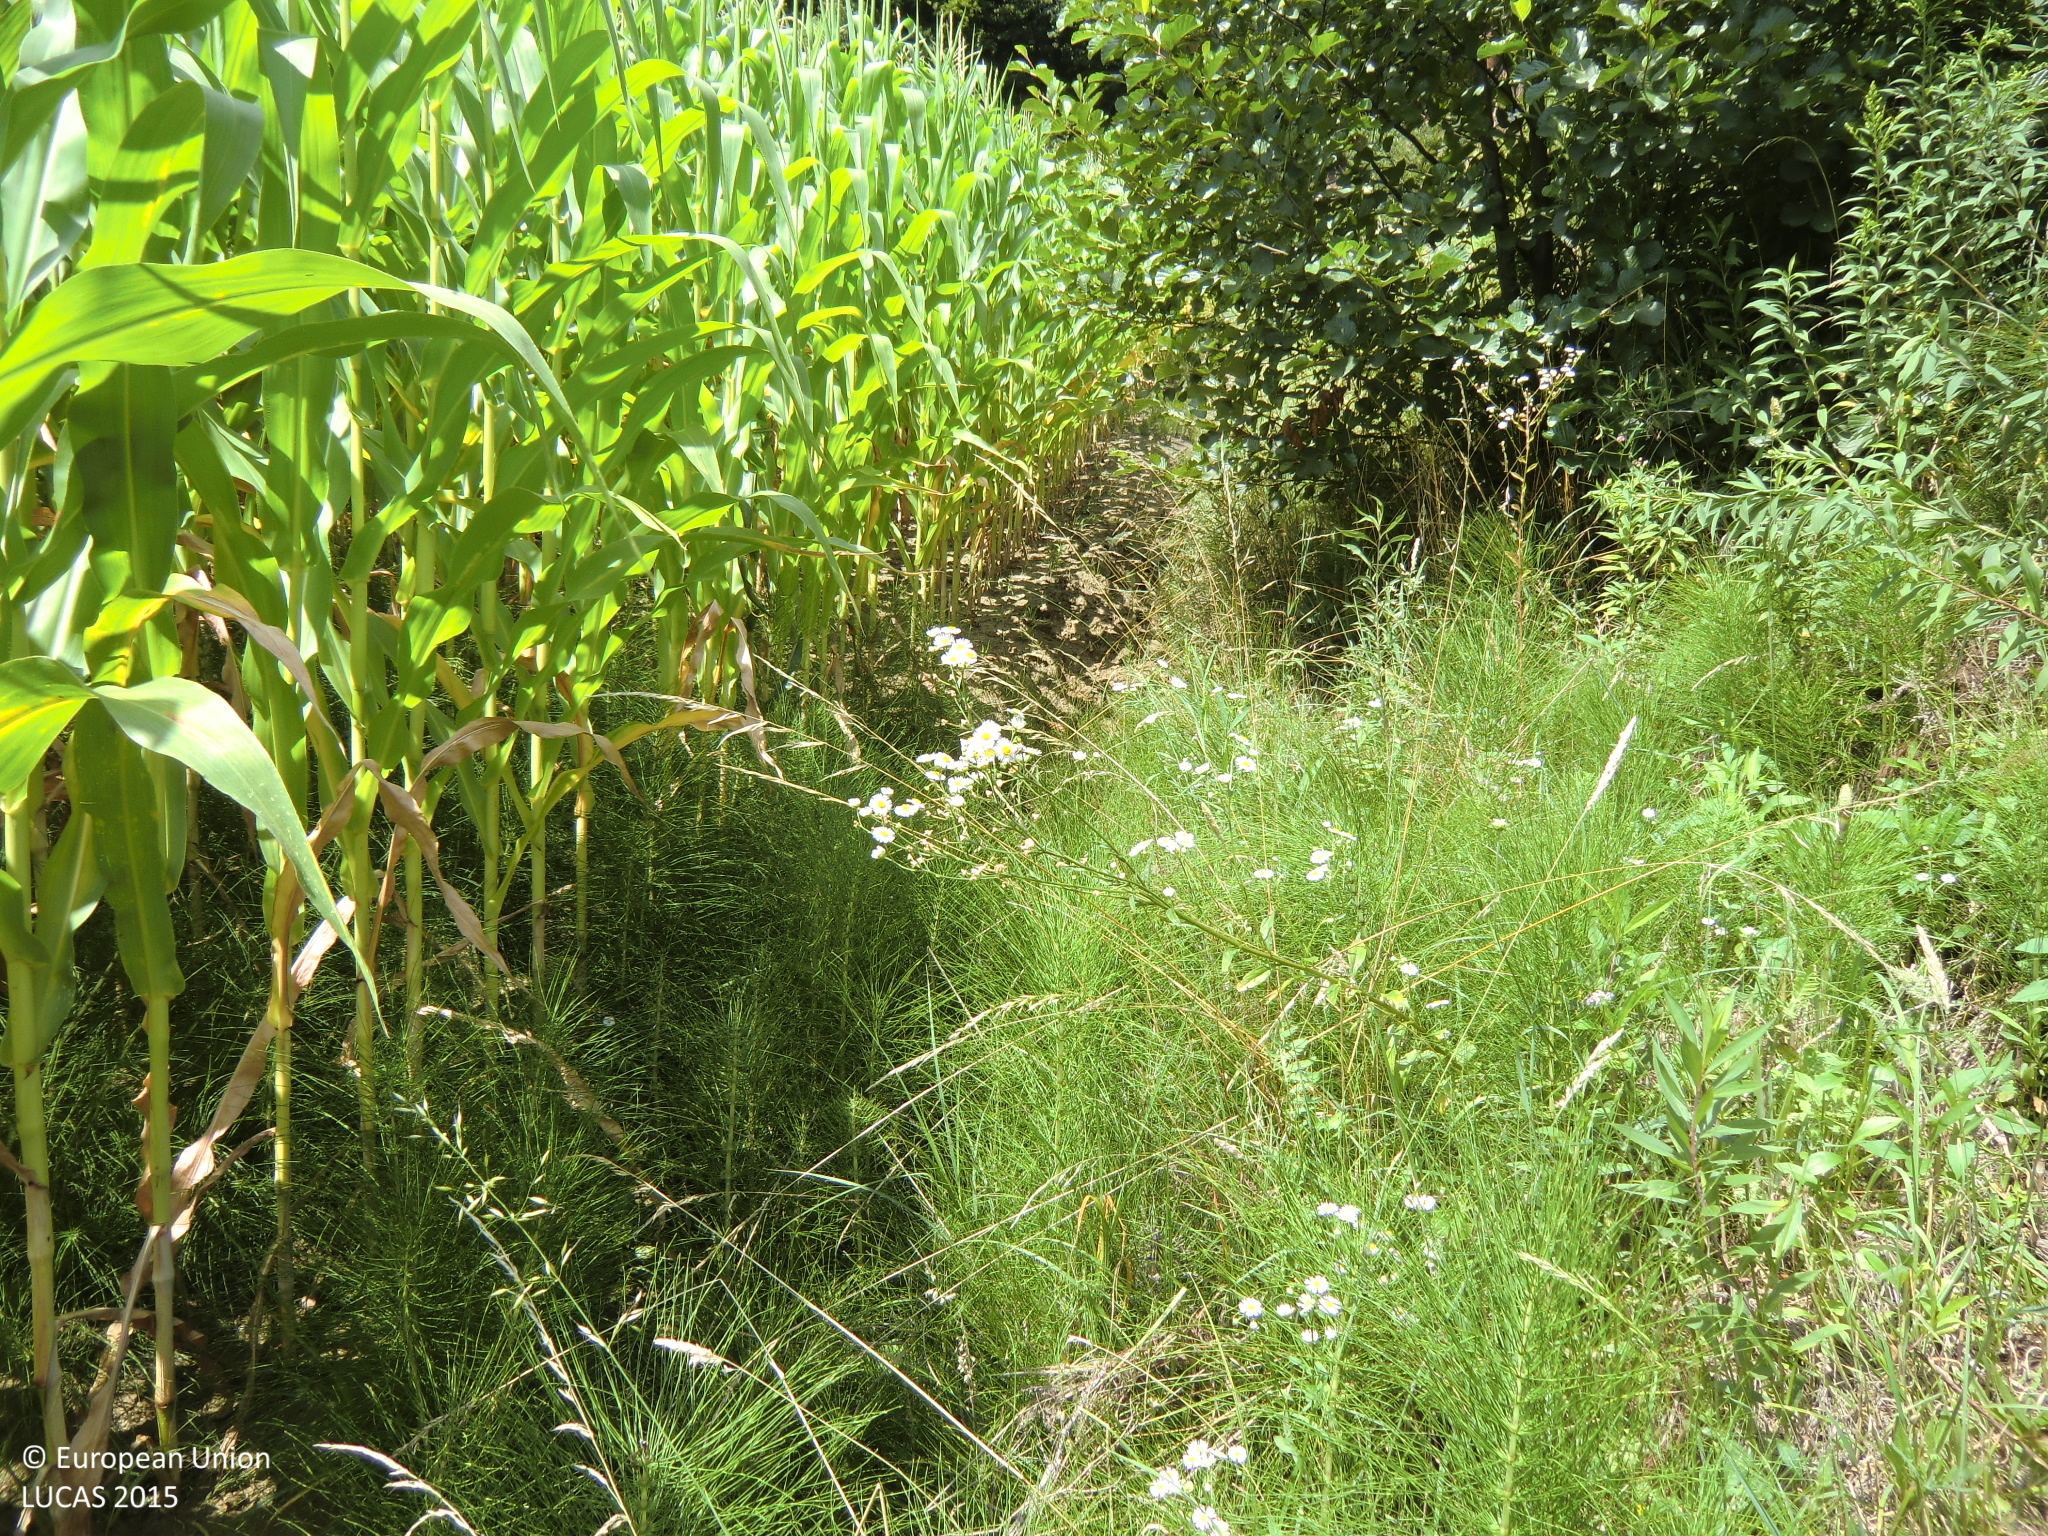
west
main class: Cropland
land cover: Maize
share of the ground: > 75 %
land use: Agriculture (excluding fallow land and kitchen gardens)
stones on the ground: < 10 %
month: July
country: AT
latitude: 46.9888
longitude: 16.1153
